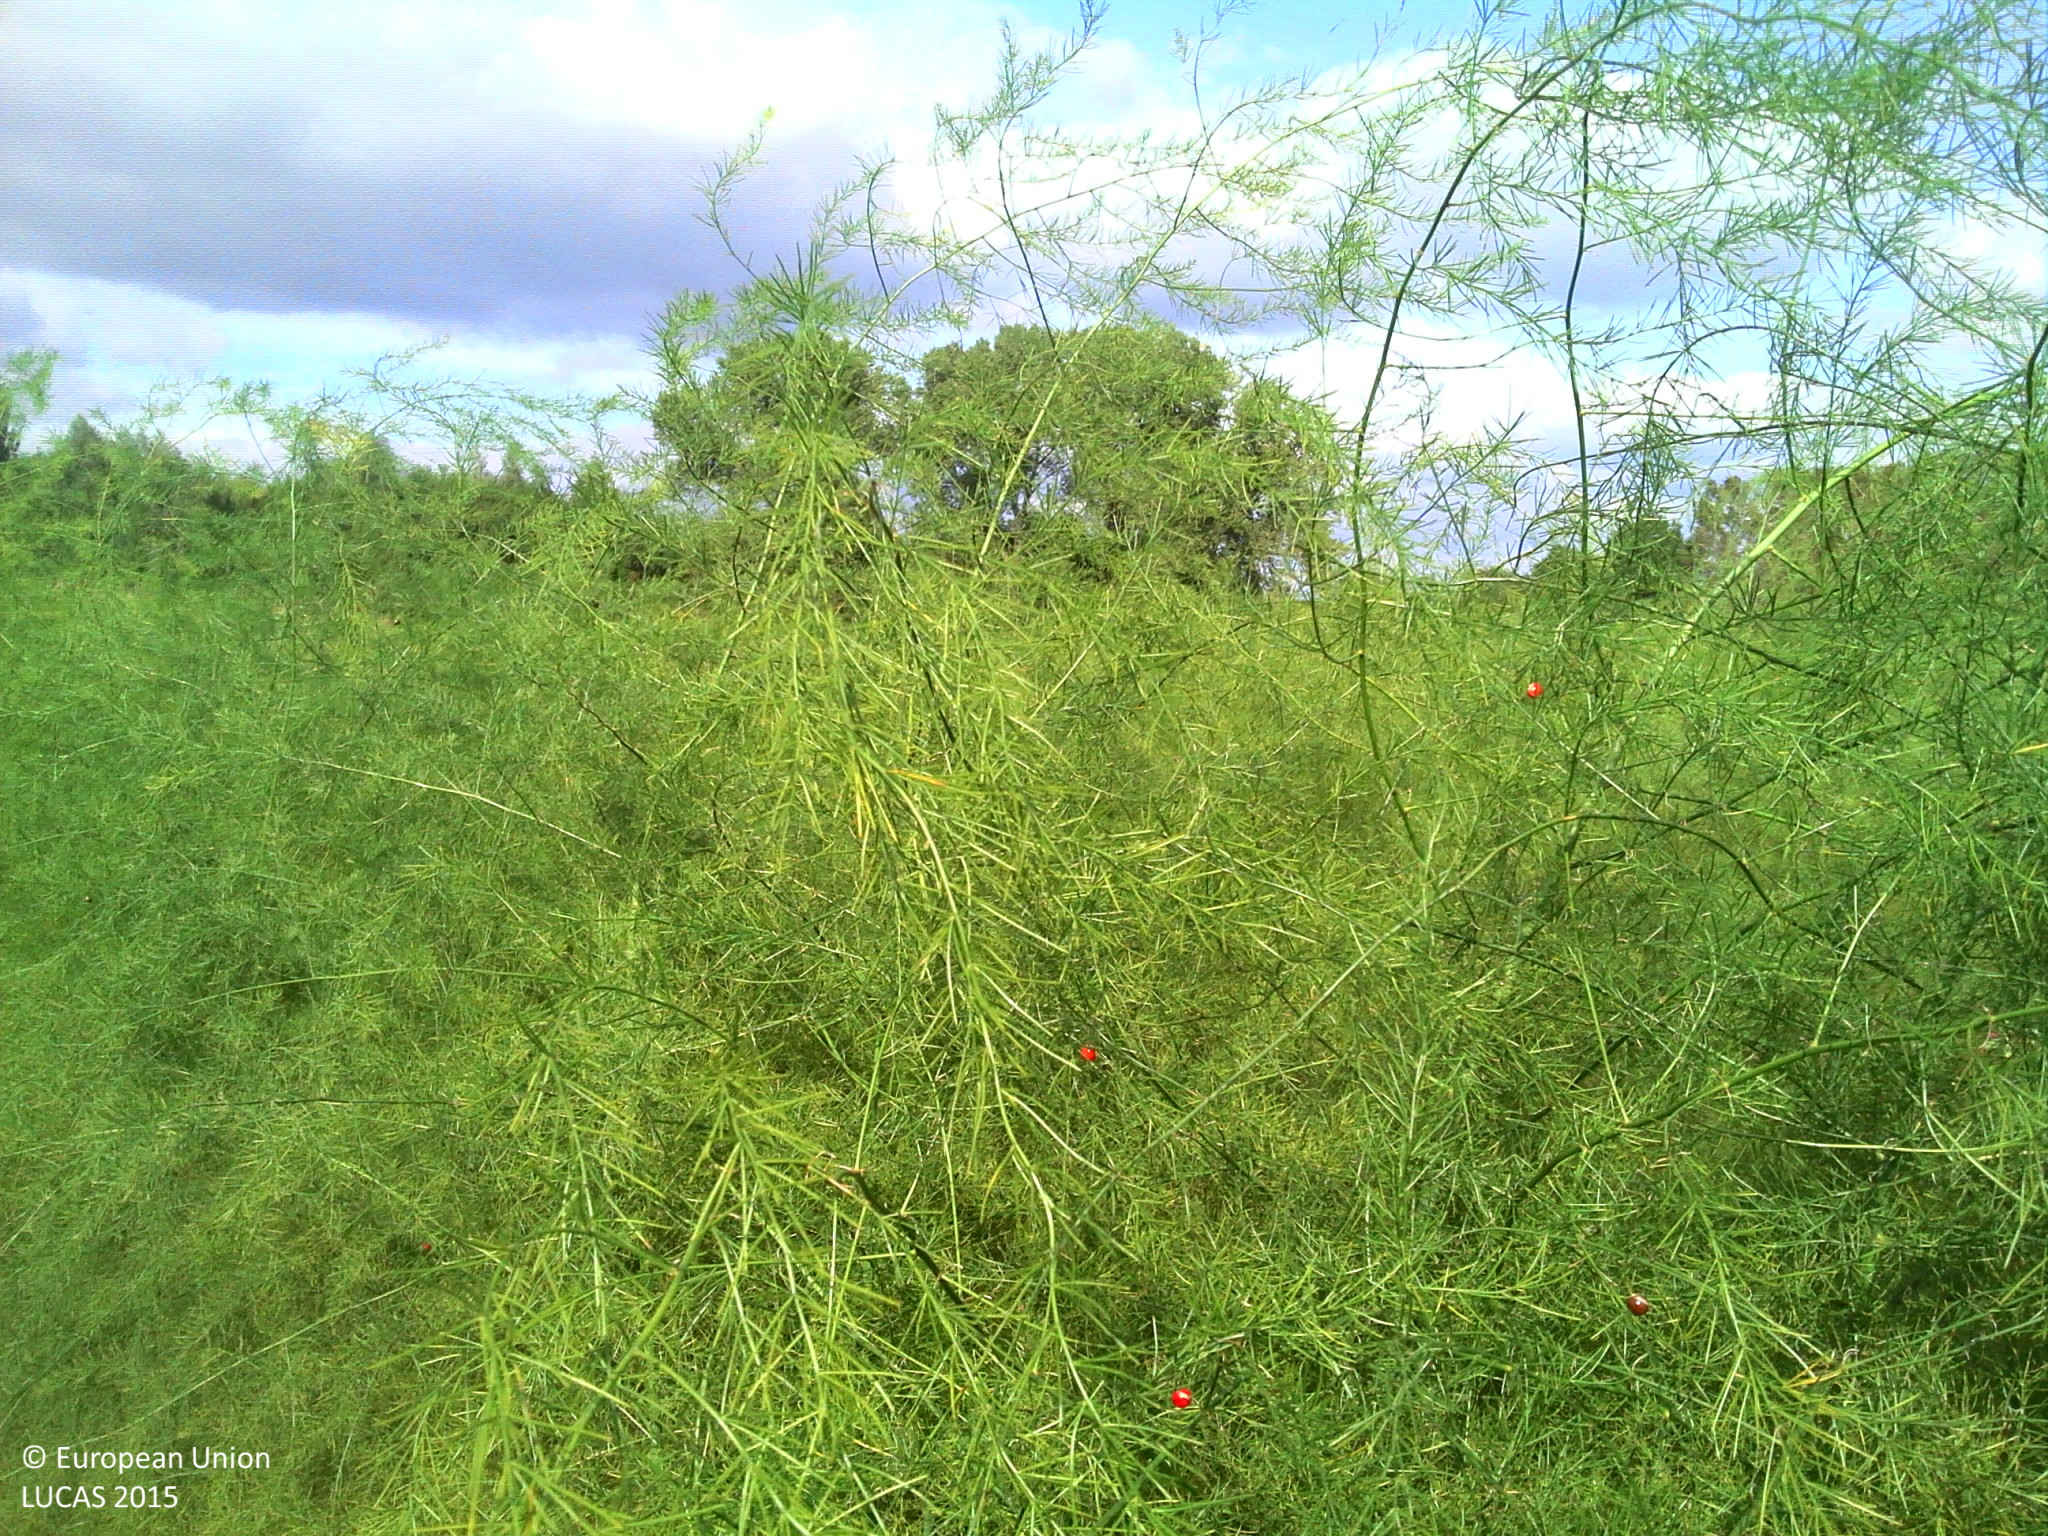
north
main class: Cropland
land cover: Other fresh vegetables
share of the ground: > 75 %
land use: Agriculture (excluding fallow land and kitchen gardens)
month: September
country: BE
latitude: 51.1200
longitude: 4.6100
